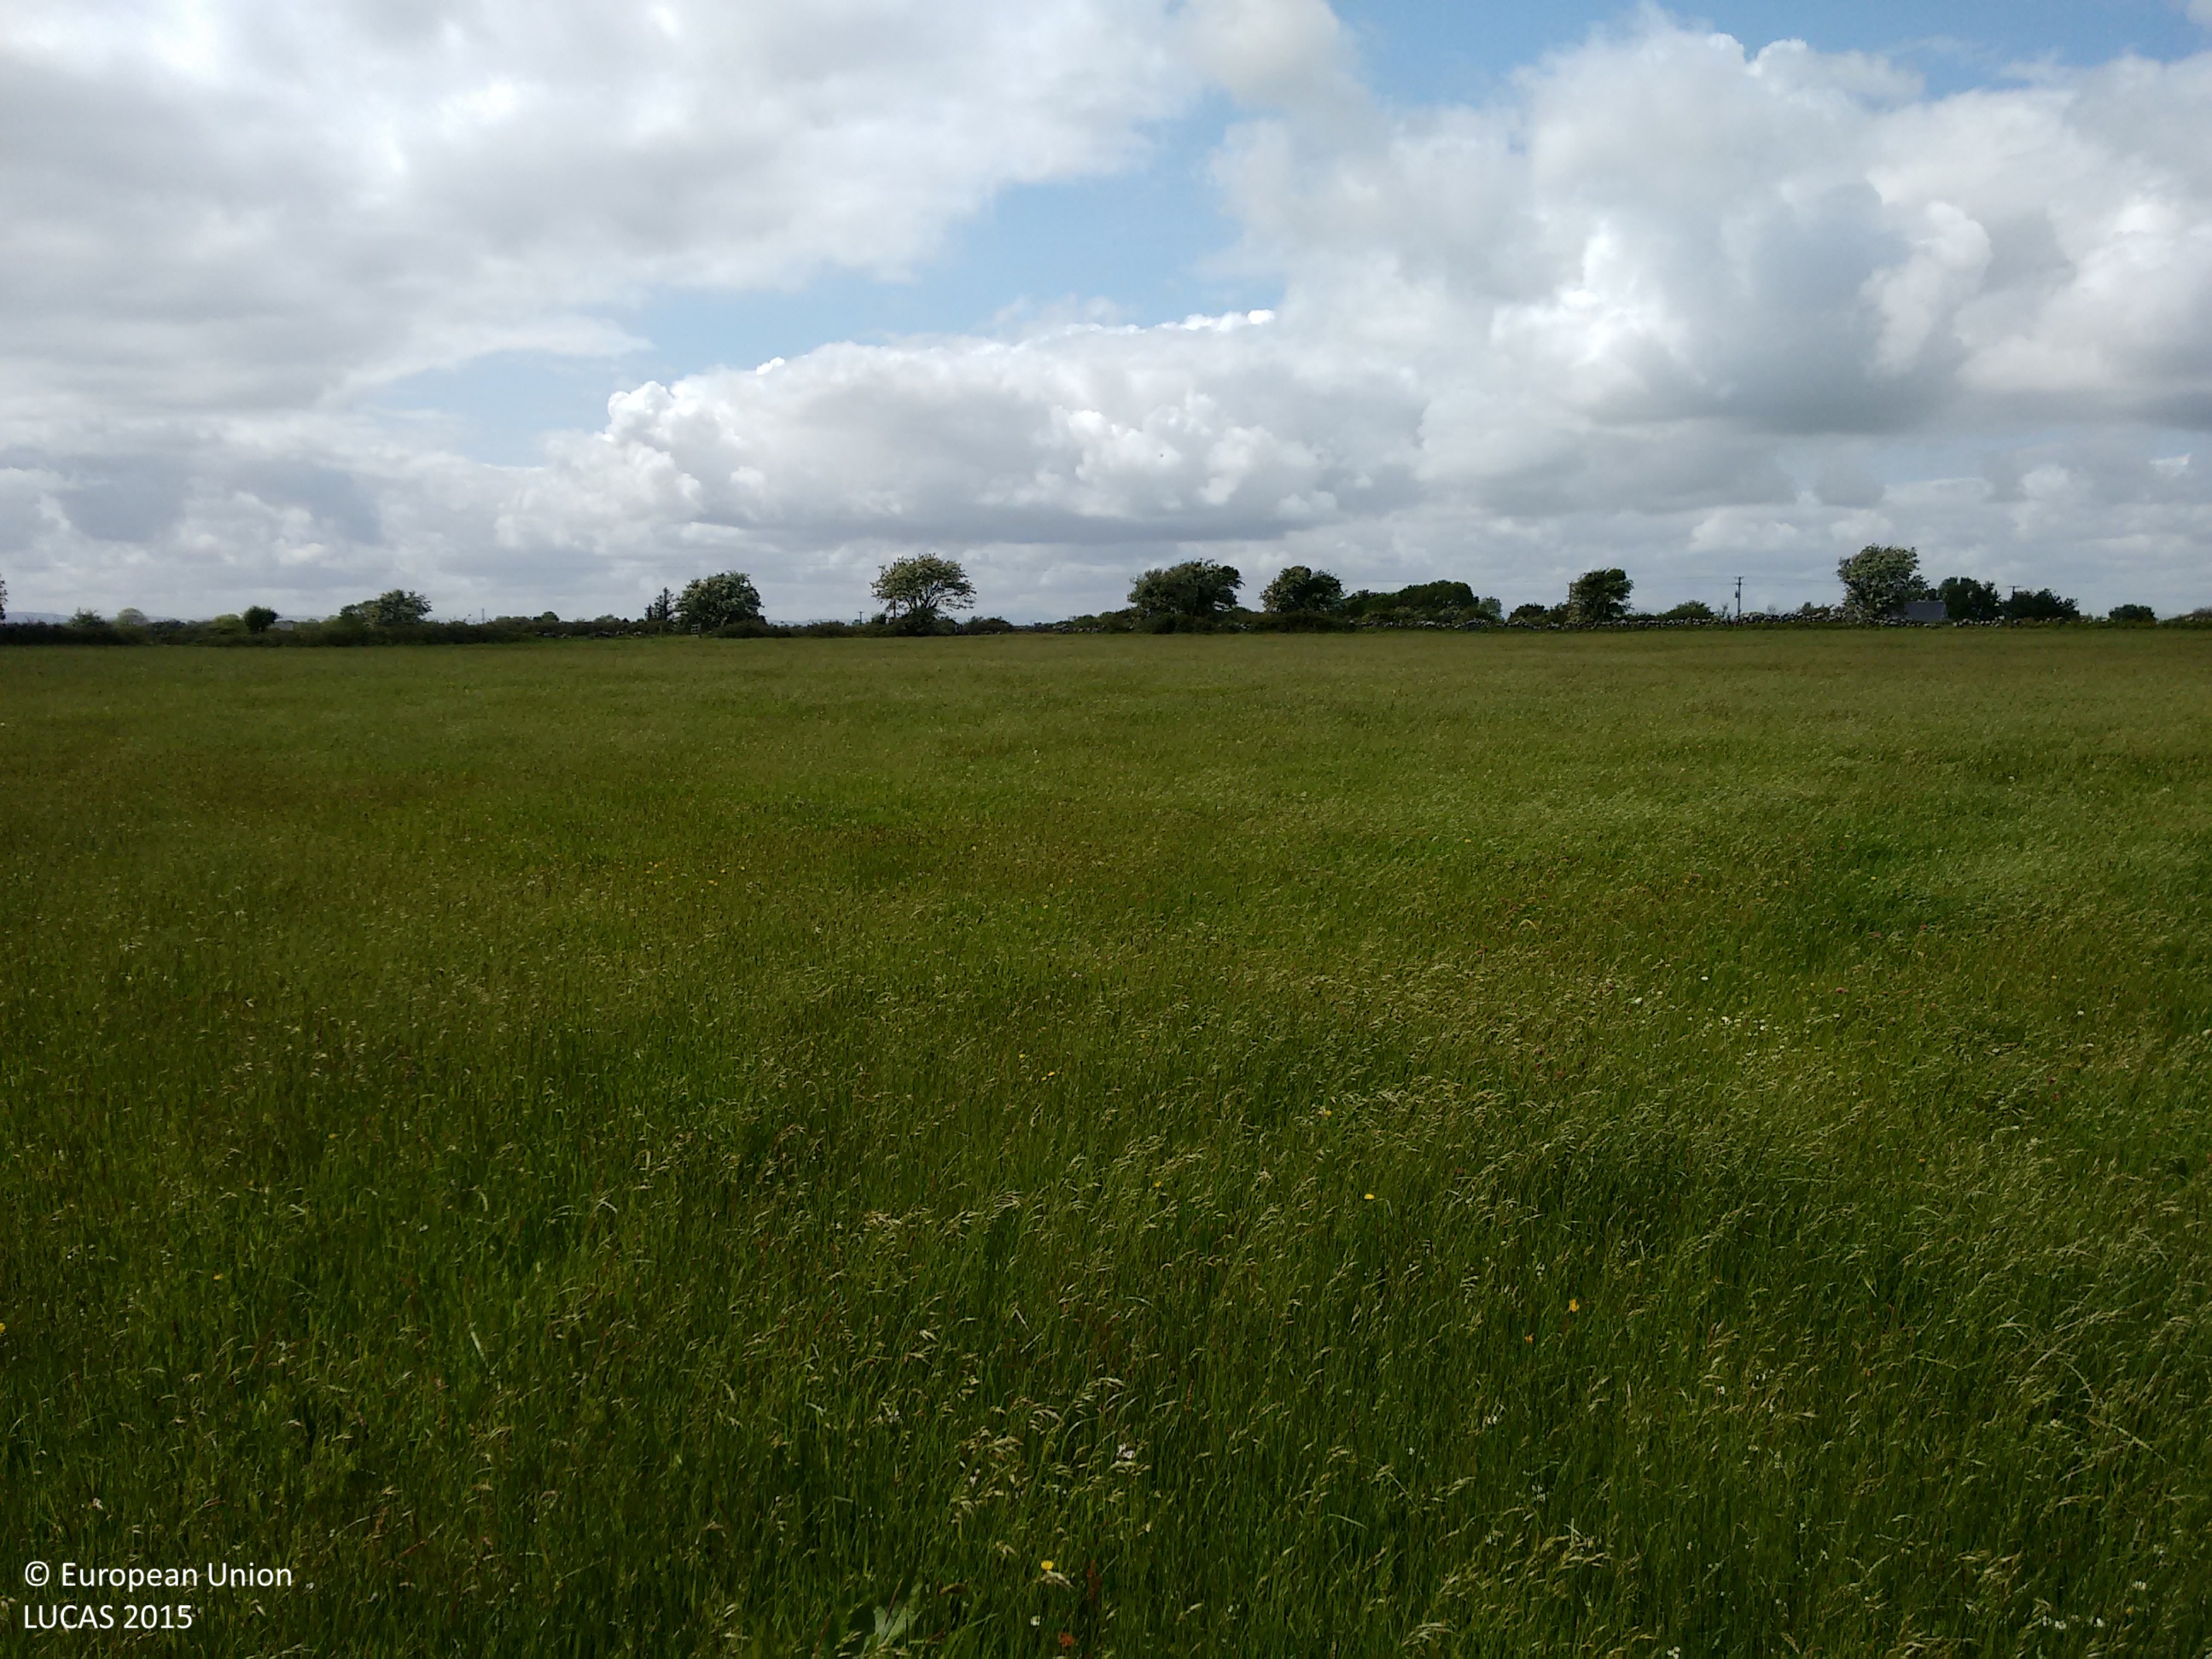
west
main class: Grassland
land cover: Grassland without tree/shrub cover
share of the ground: > 75 %
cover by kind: herbaceous plants 100 %
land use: Agriculture (excluding fallow land and kitchen gardens)
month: June
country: IE
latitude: 53.4515
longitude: -8.9897
